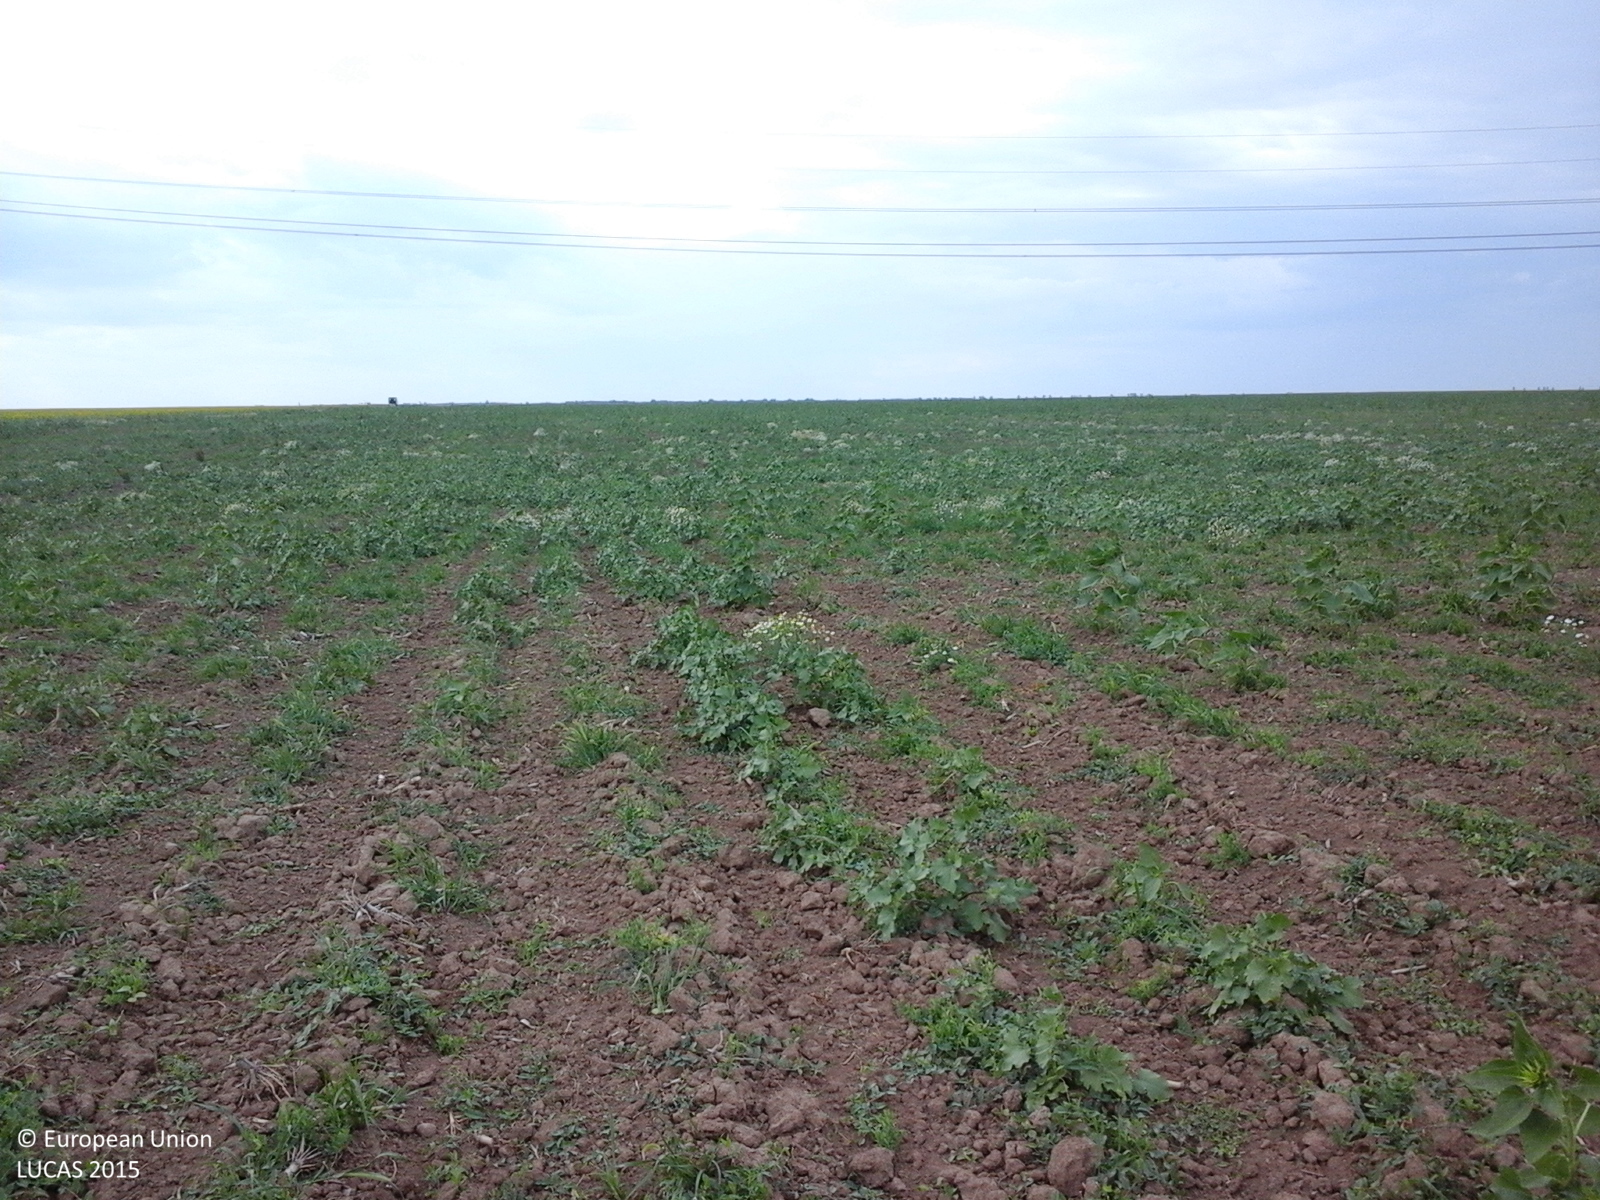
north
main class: Grassland
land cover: Spontaneously vegetated surfaces
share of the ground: 25 - 50 %
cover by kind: herbaceous plants 100 %
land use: Fallow land
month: July
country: RO
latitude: 44.3000
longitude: 24.8540
